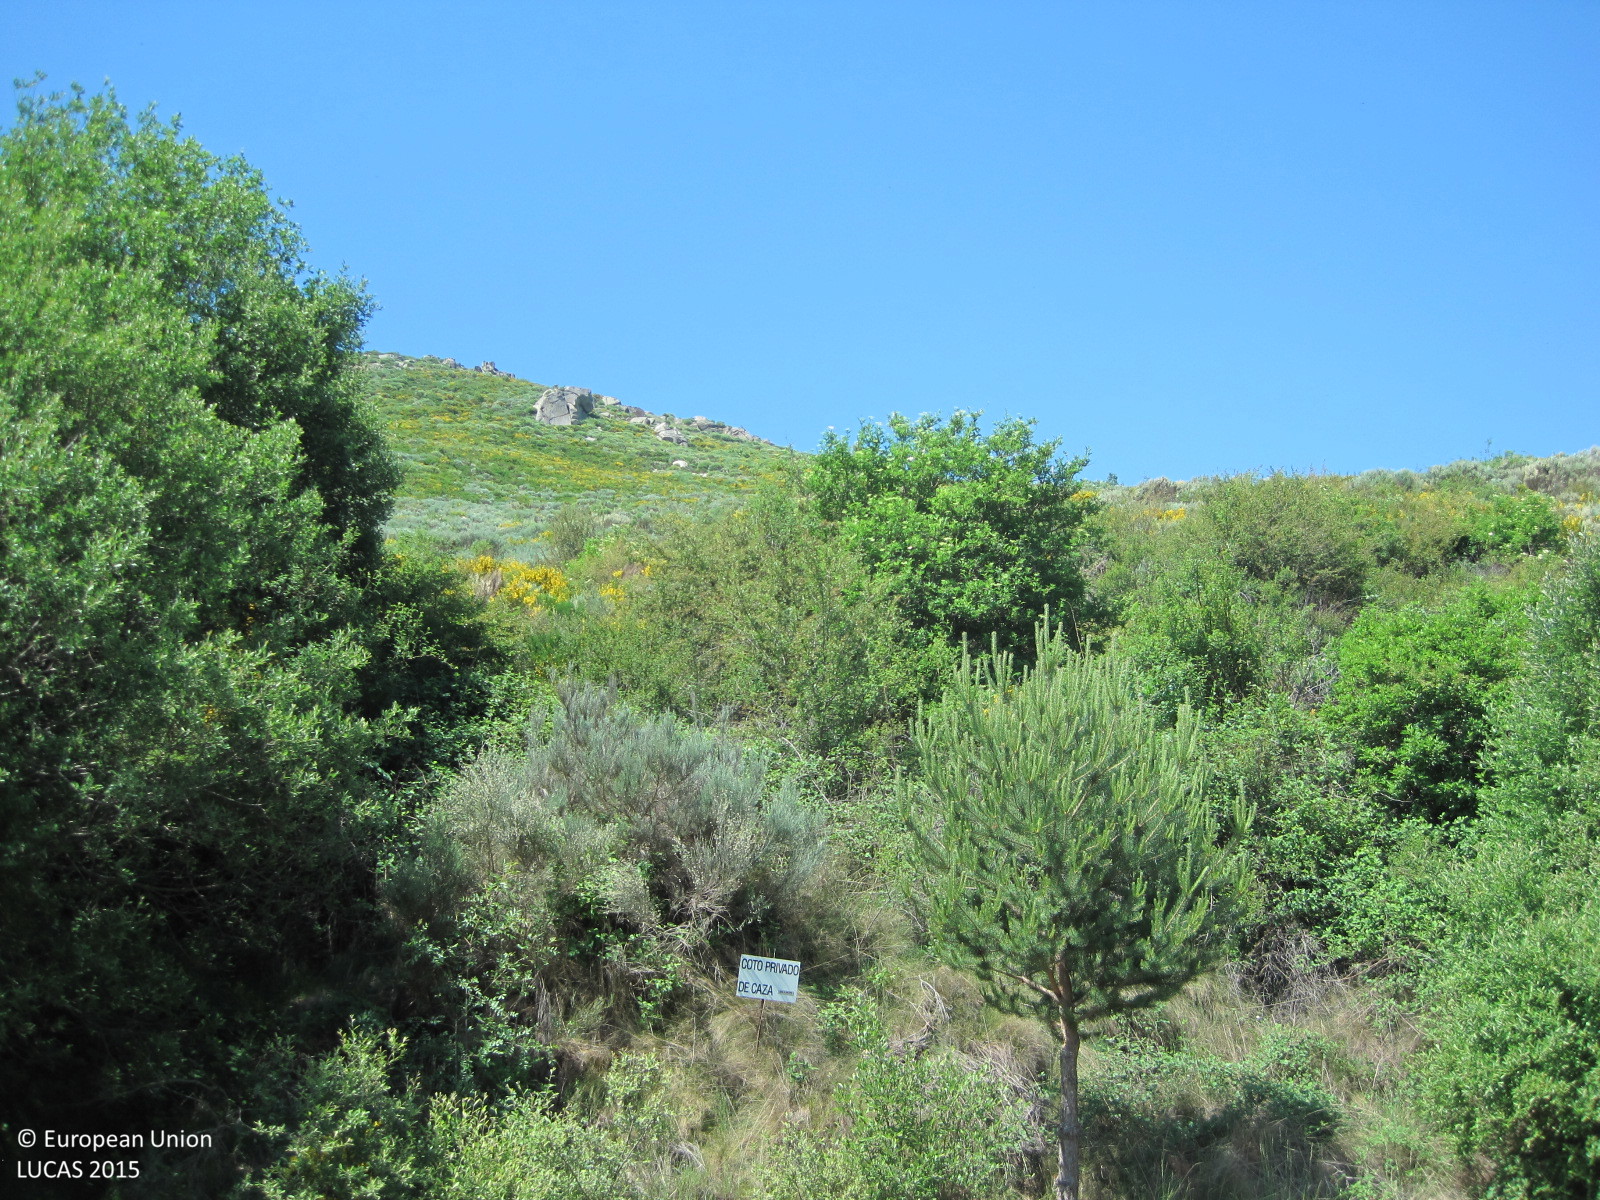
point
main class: Shrubland
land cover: Shrubland without tree cover
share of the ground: > 75 %
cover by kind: shrubs 100 %
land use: Semi-natural and natural areas not in use
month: June
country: ES
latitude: 40.4053
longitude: -5.0341
